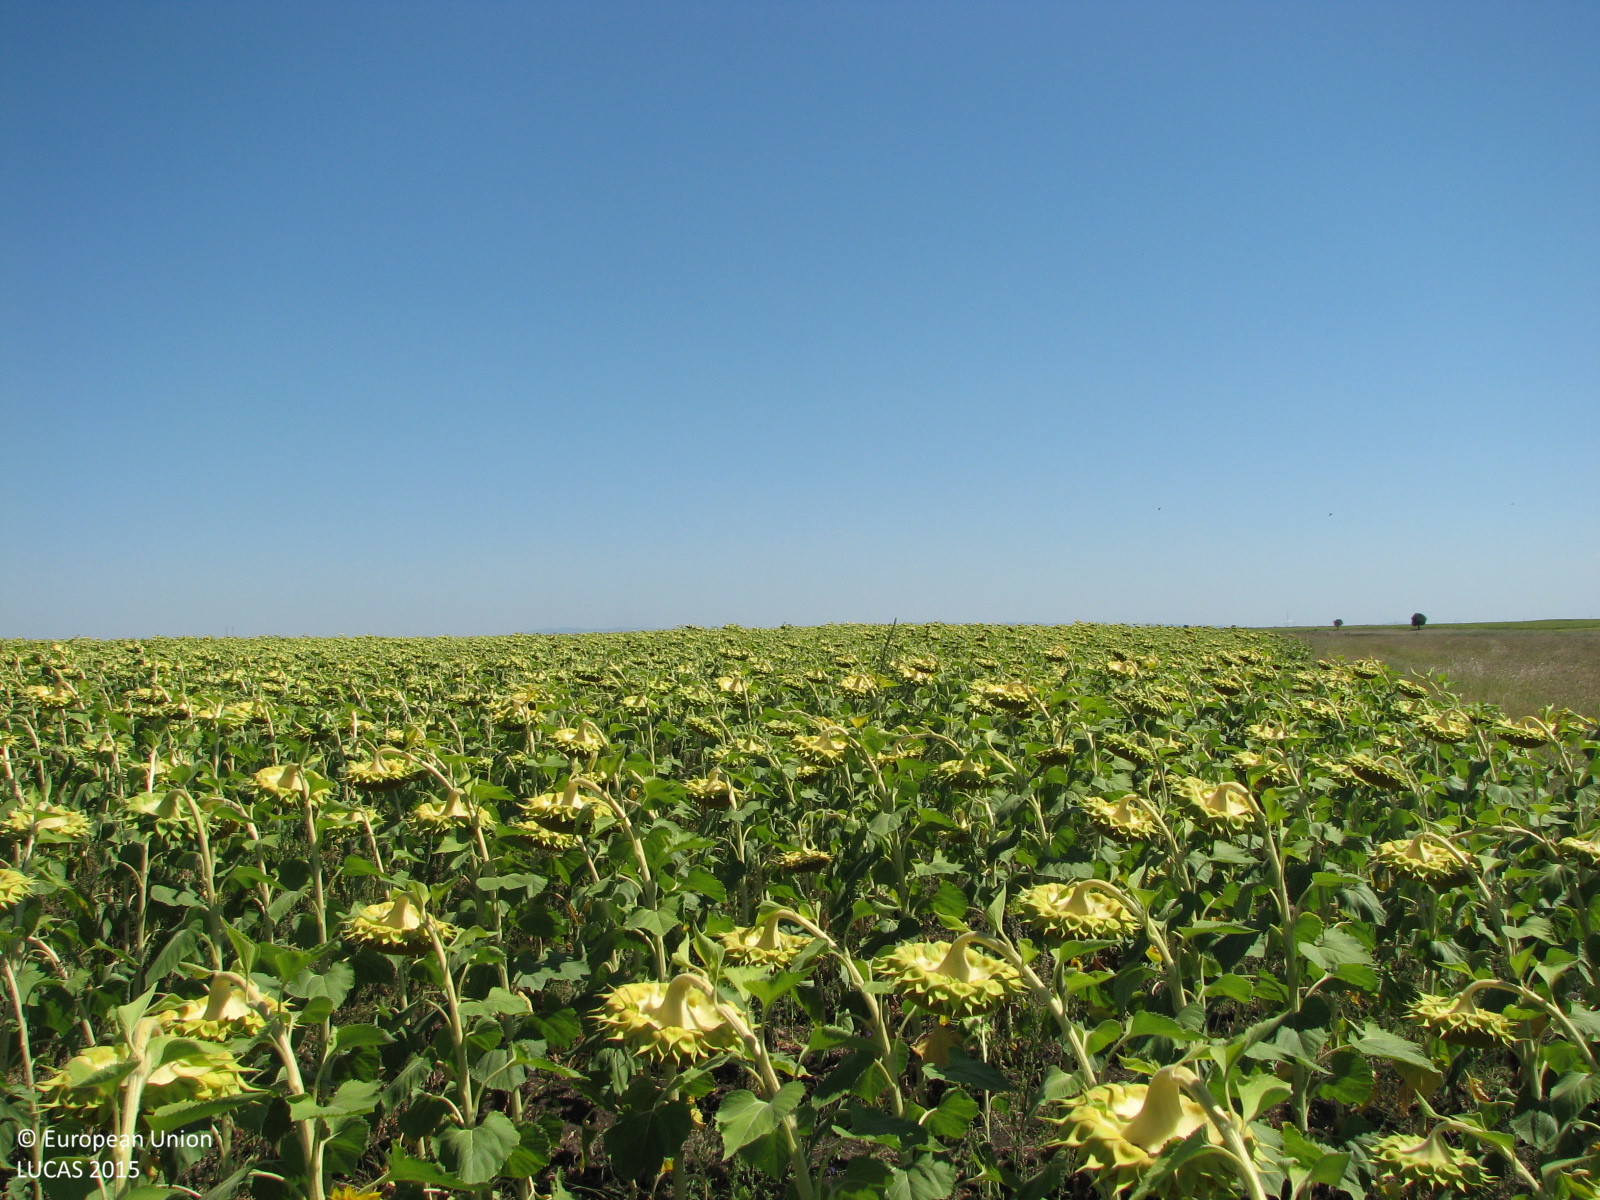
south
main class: Cropland
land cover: Sunflower
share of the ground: > 75 %
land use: Agriculture (excluding fallow land and kitchen gardens)
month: July
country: BG
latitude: 42.3941
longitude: 25.9312
